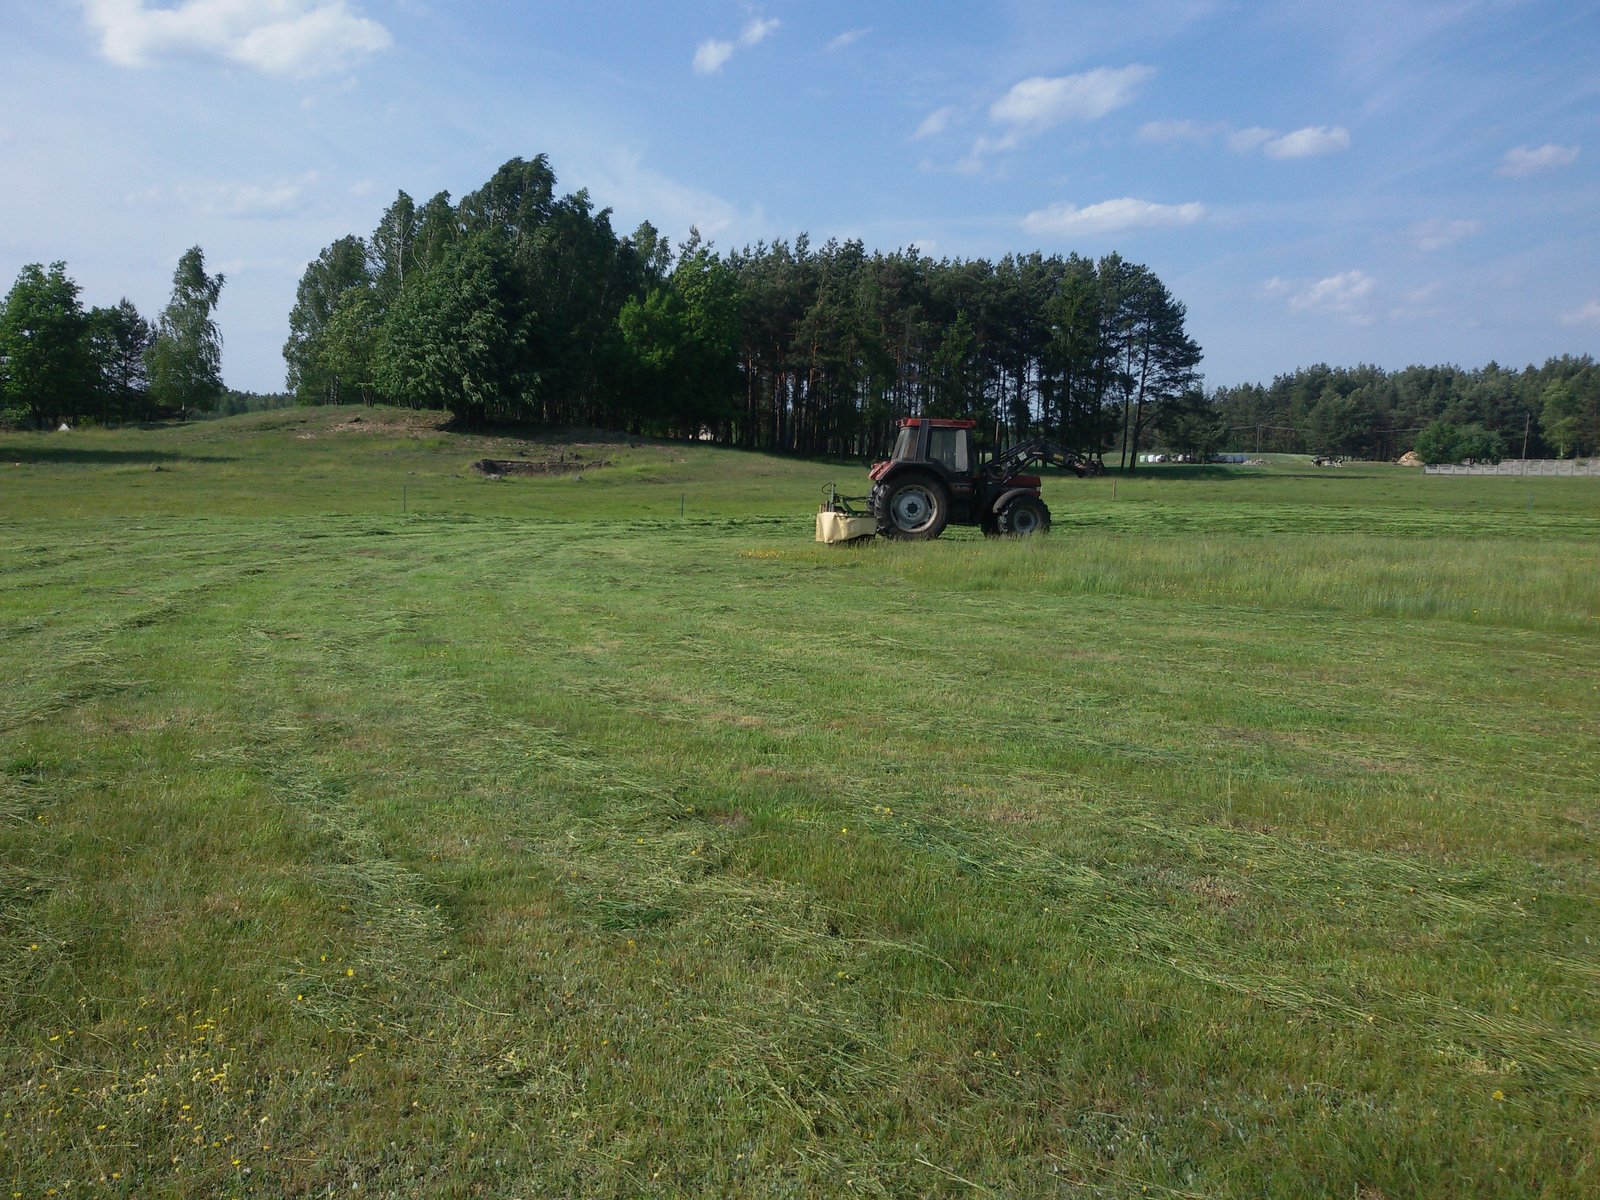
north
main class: Grassland
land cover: Grassland without tree/shrub cover
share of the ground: > 75 %
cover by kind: herbaceous plants 100 %
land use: Agriculture (excluding fallow land and kitchen gardens)
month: June
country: PL
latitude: 53.4301
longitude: 21.5343
